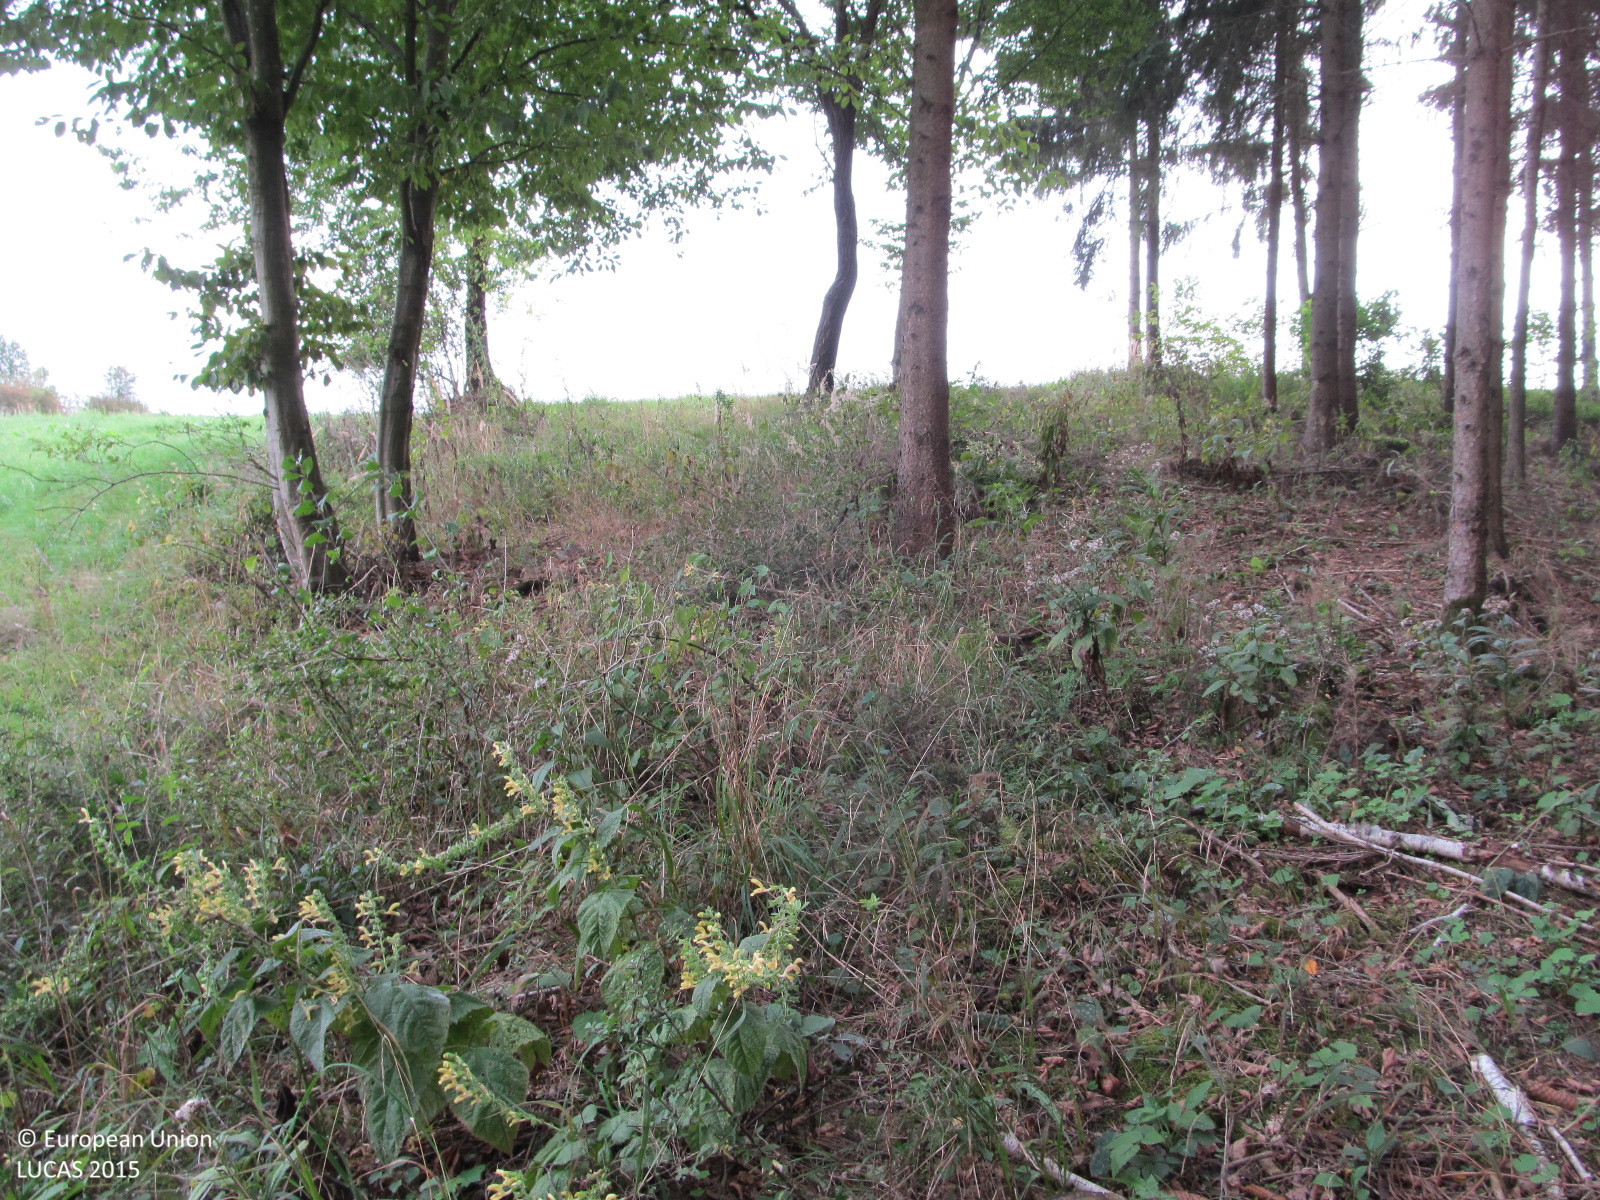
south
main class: Woodland
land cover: Spruce dominated coniferous woodland
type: hemiboreal forest and nemoral coniferous forest and mixed broadleaved-coniferous forest
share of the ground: > 75 %
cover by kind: coniferous forest trees 80 %, unconsolidated bare surface 20 %
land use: Forestry
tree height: > 5 m
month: September
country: AT
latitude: 48.6108
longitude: 15.4688
